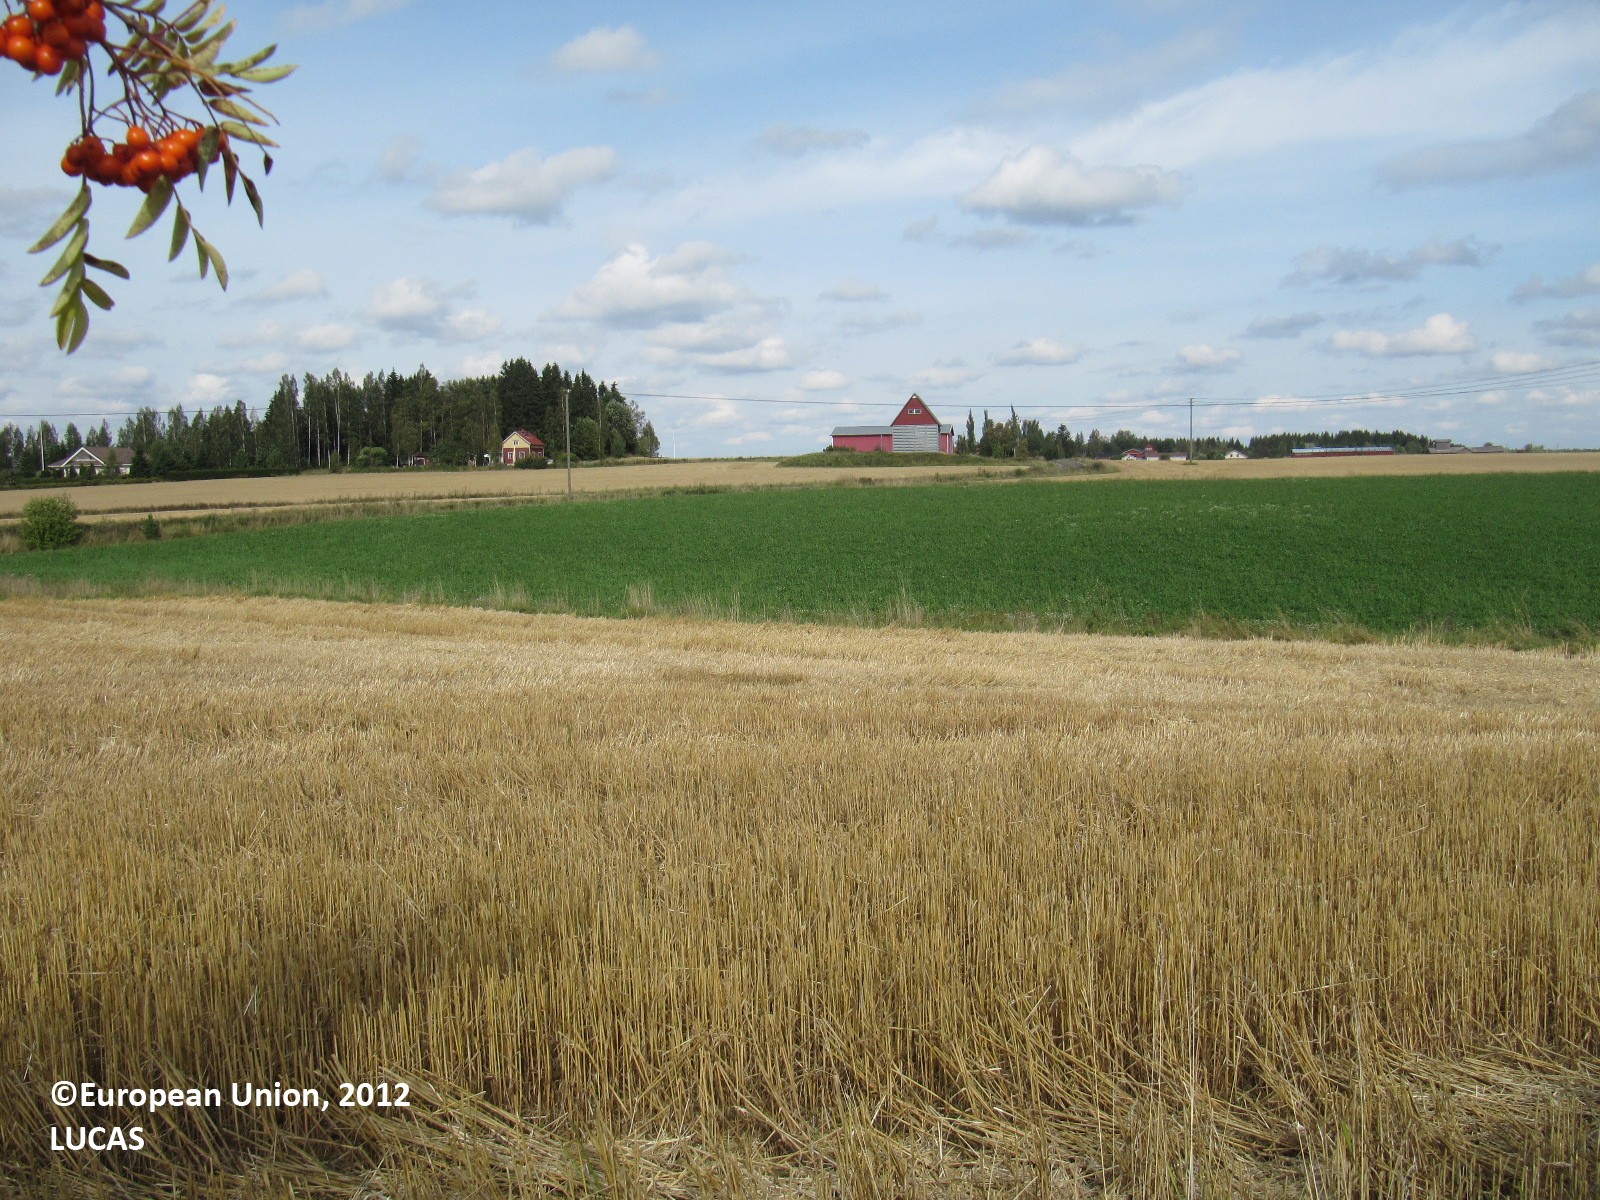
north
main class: Cropland
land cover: Common wheat
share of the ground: > 75 %
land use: Agriculture (excluding fallow land and kitchen gardens)
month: August
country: FI
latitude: 60.9590
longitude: 22.8706
